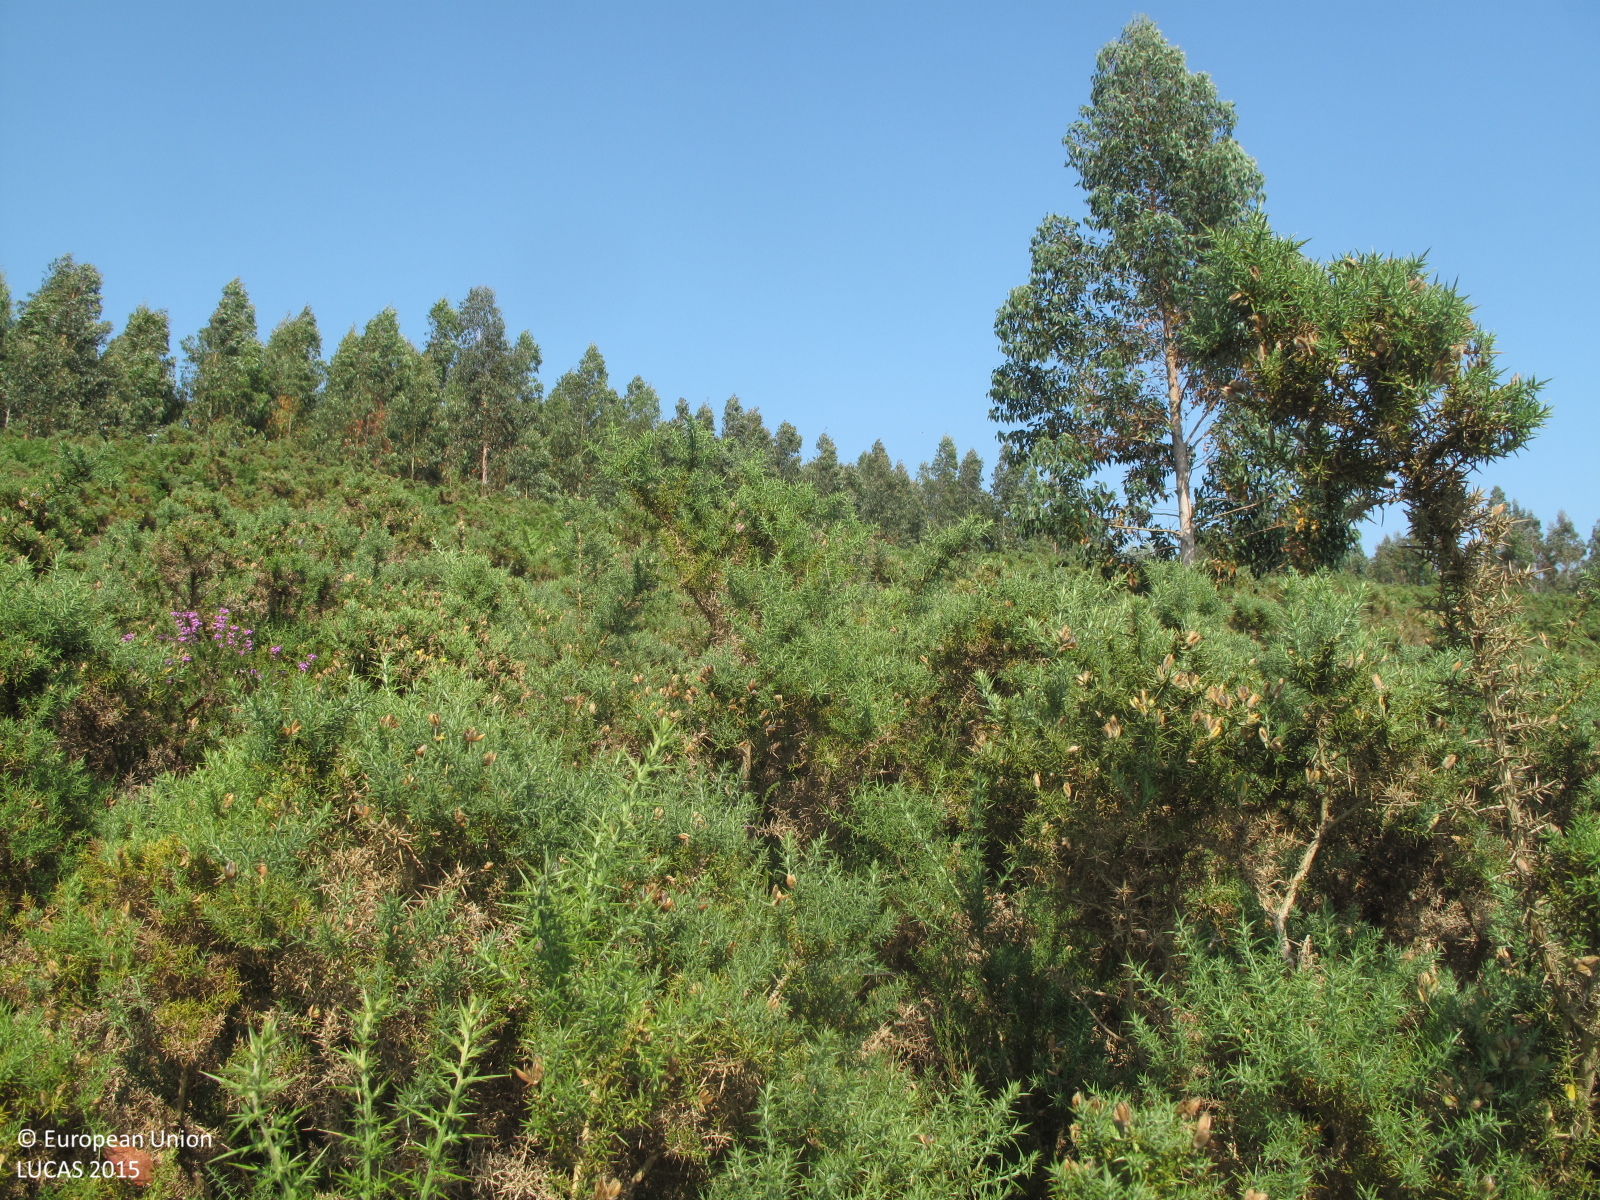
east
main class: Shrubland
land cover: Shrubland without tree cover
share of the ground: > 75 %
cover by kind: shrubs 90 %, herbaceous plants 10 %
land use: Semi-natural and natural areas not in use
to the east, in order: Shrubland without tree cover; Shrubland with sparse tree cover; Shrubland without tree cover; Tracks; Broadleaved woodland
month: June
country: ES
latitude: 43.2382
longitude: -8.0106
